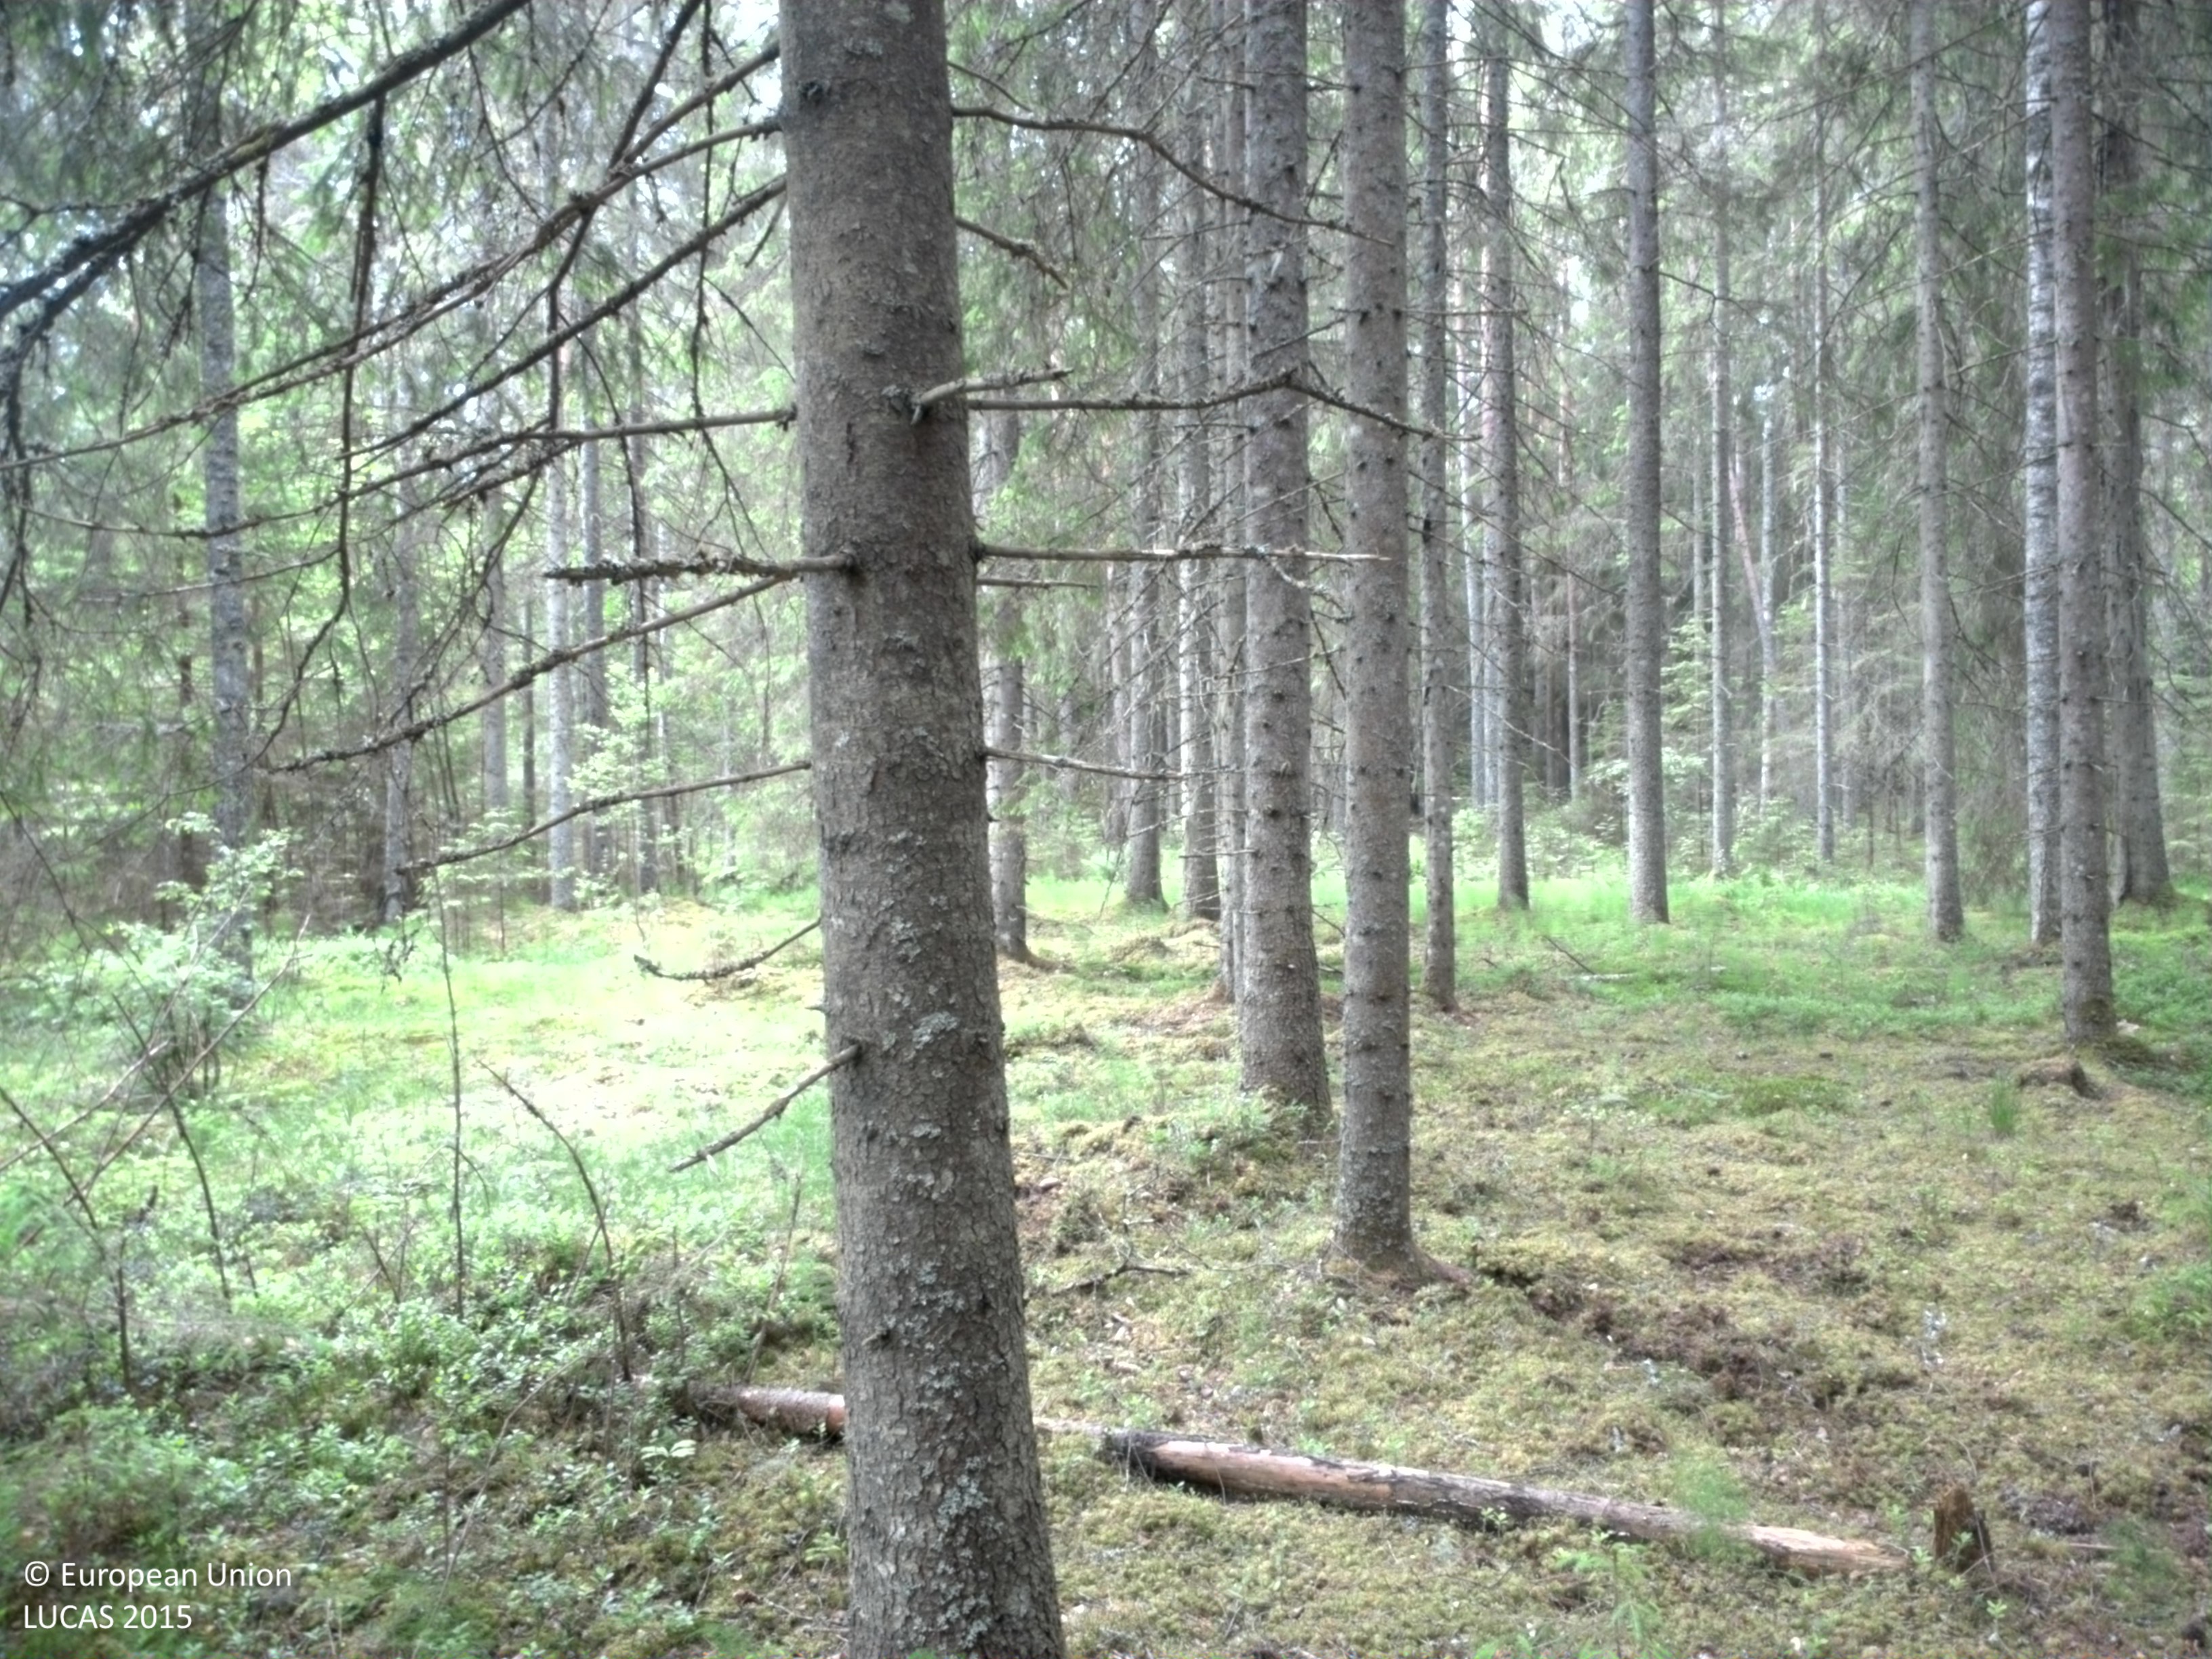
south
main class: Woodland
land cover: Spruce dominated coniferous woodland
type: boreal forest
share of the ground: 50 - 75 %
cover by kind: coniferous forest trees 45 %, lichens and mosses 35 %, broadleaved forest trees 15 %, shrubs 5 %
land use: Forestry
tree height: > 5 m
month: June
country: SE
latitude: 59.8372
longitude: 12.3309
